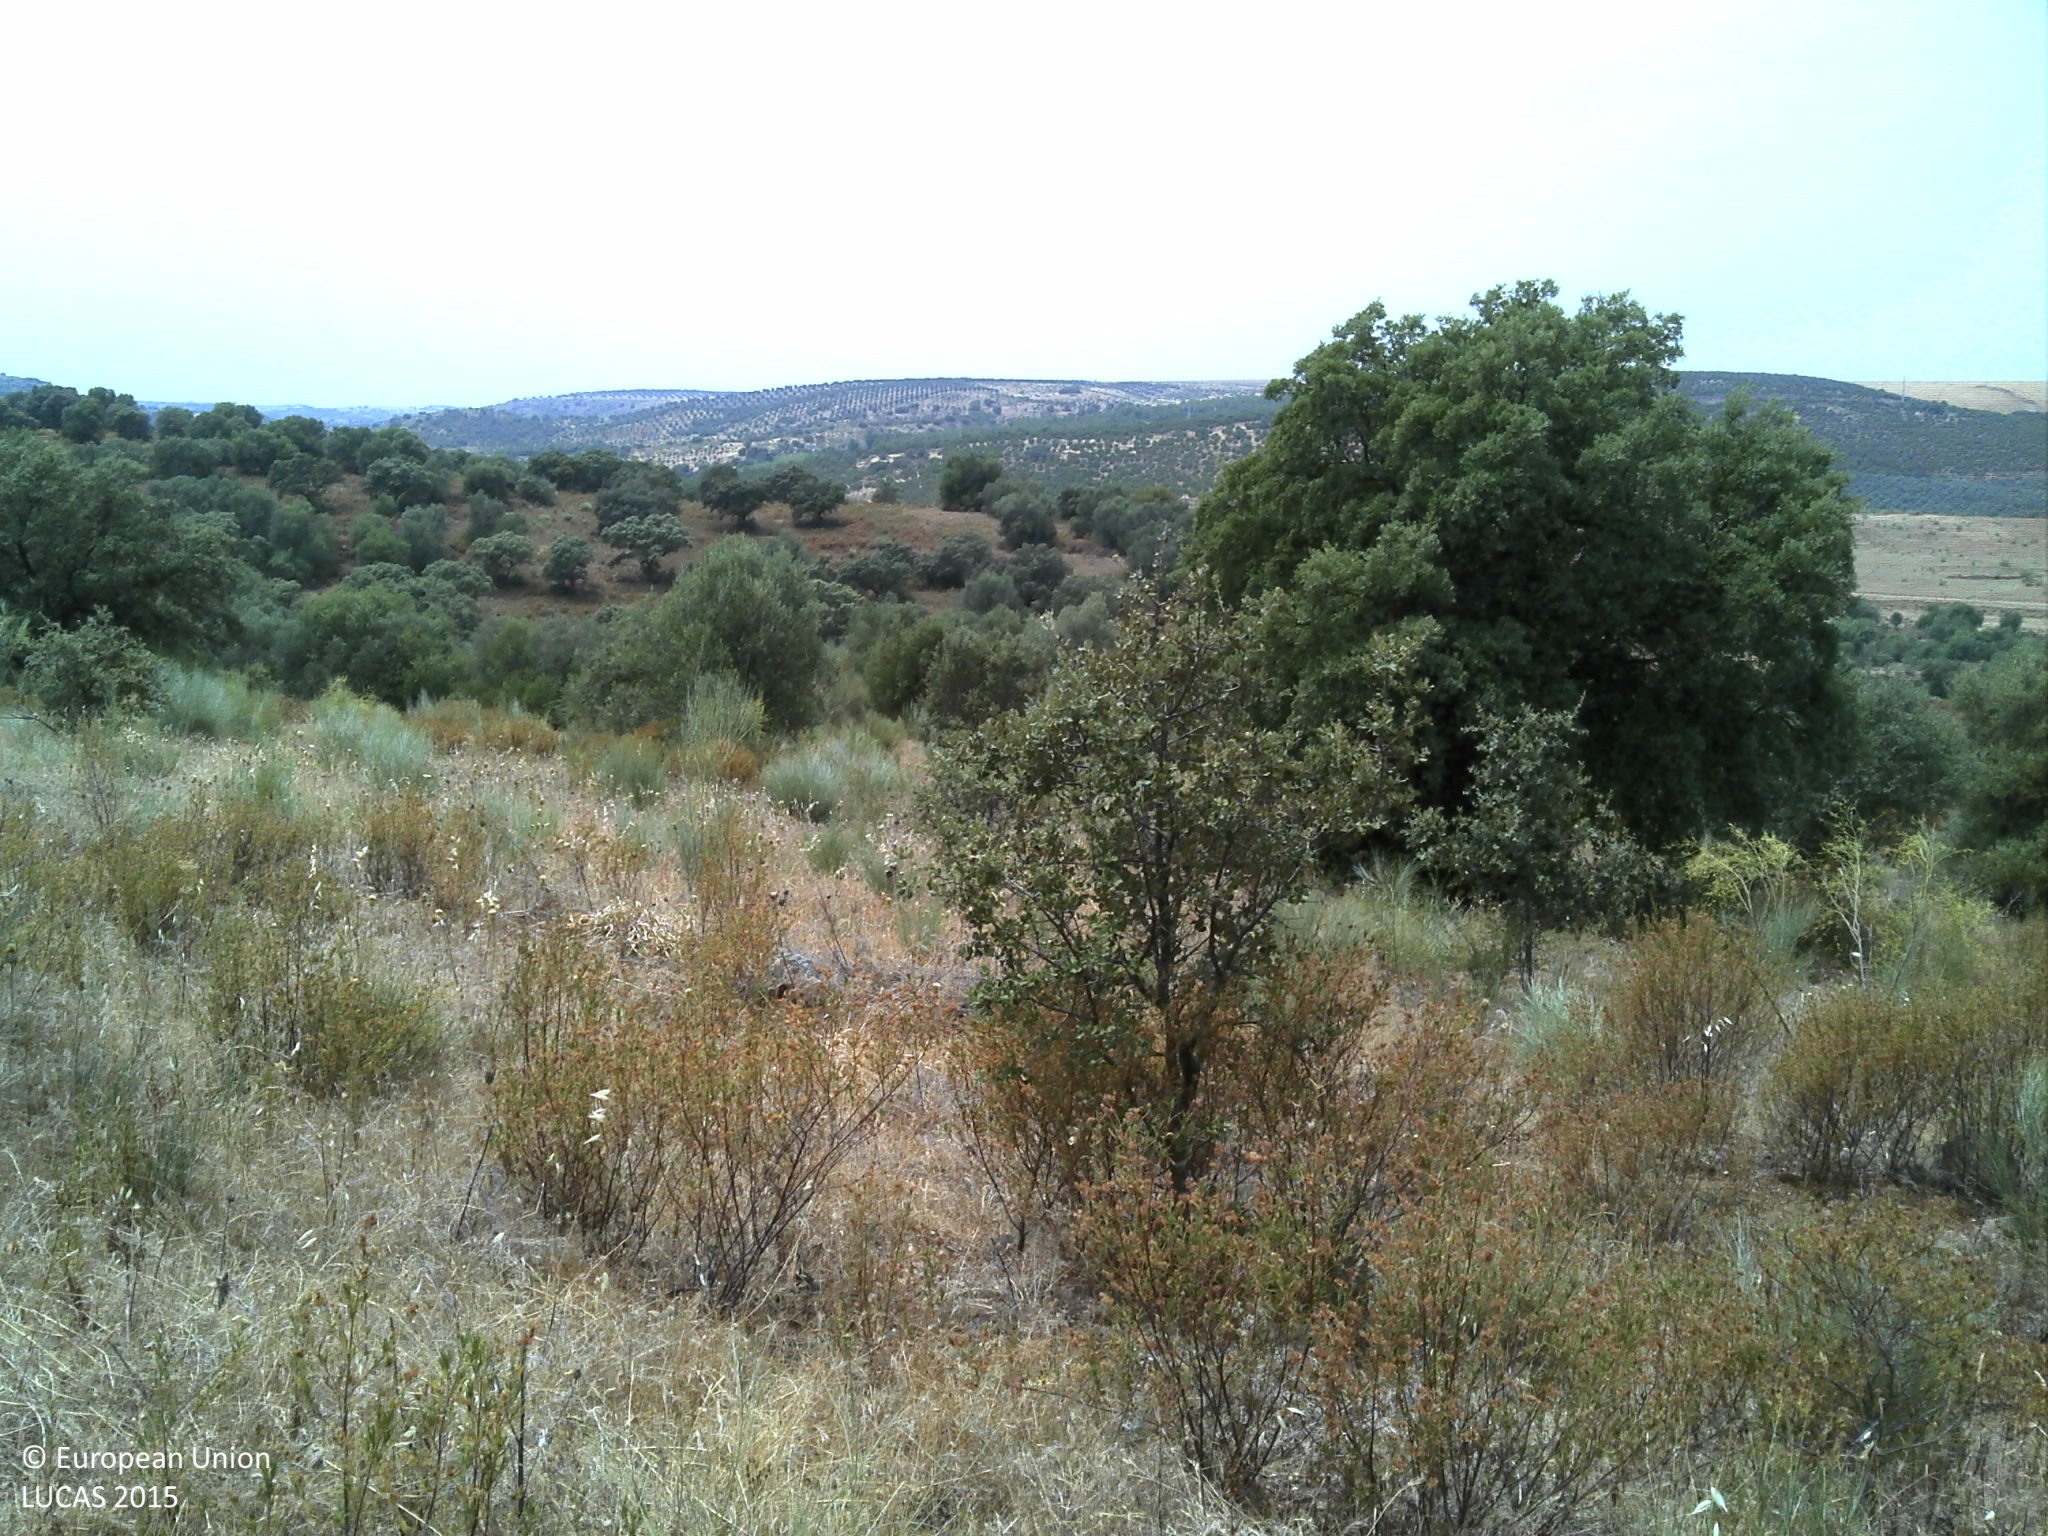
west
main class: Woodland
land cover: Broadleaved woodland
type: broadleaved evergreen forest
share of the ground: 10 - 25 %
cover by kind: herbaceous plants 60 %, broadleaved forest trees 25 %, unconsolidated bare surface 10 %, shrubs 5 %
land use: Forestry
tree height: > 5 m
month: June
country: PT
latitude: 37.9465
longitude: -7.6718
